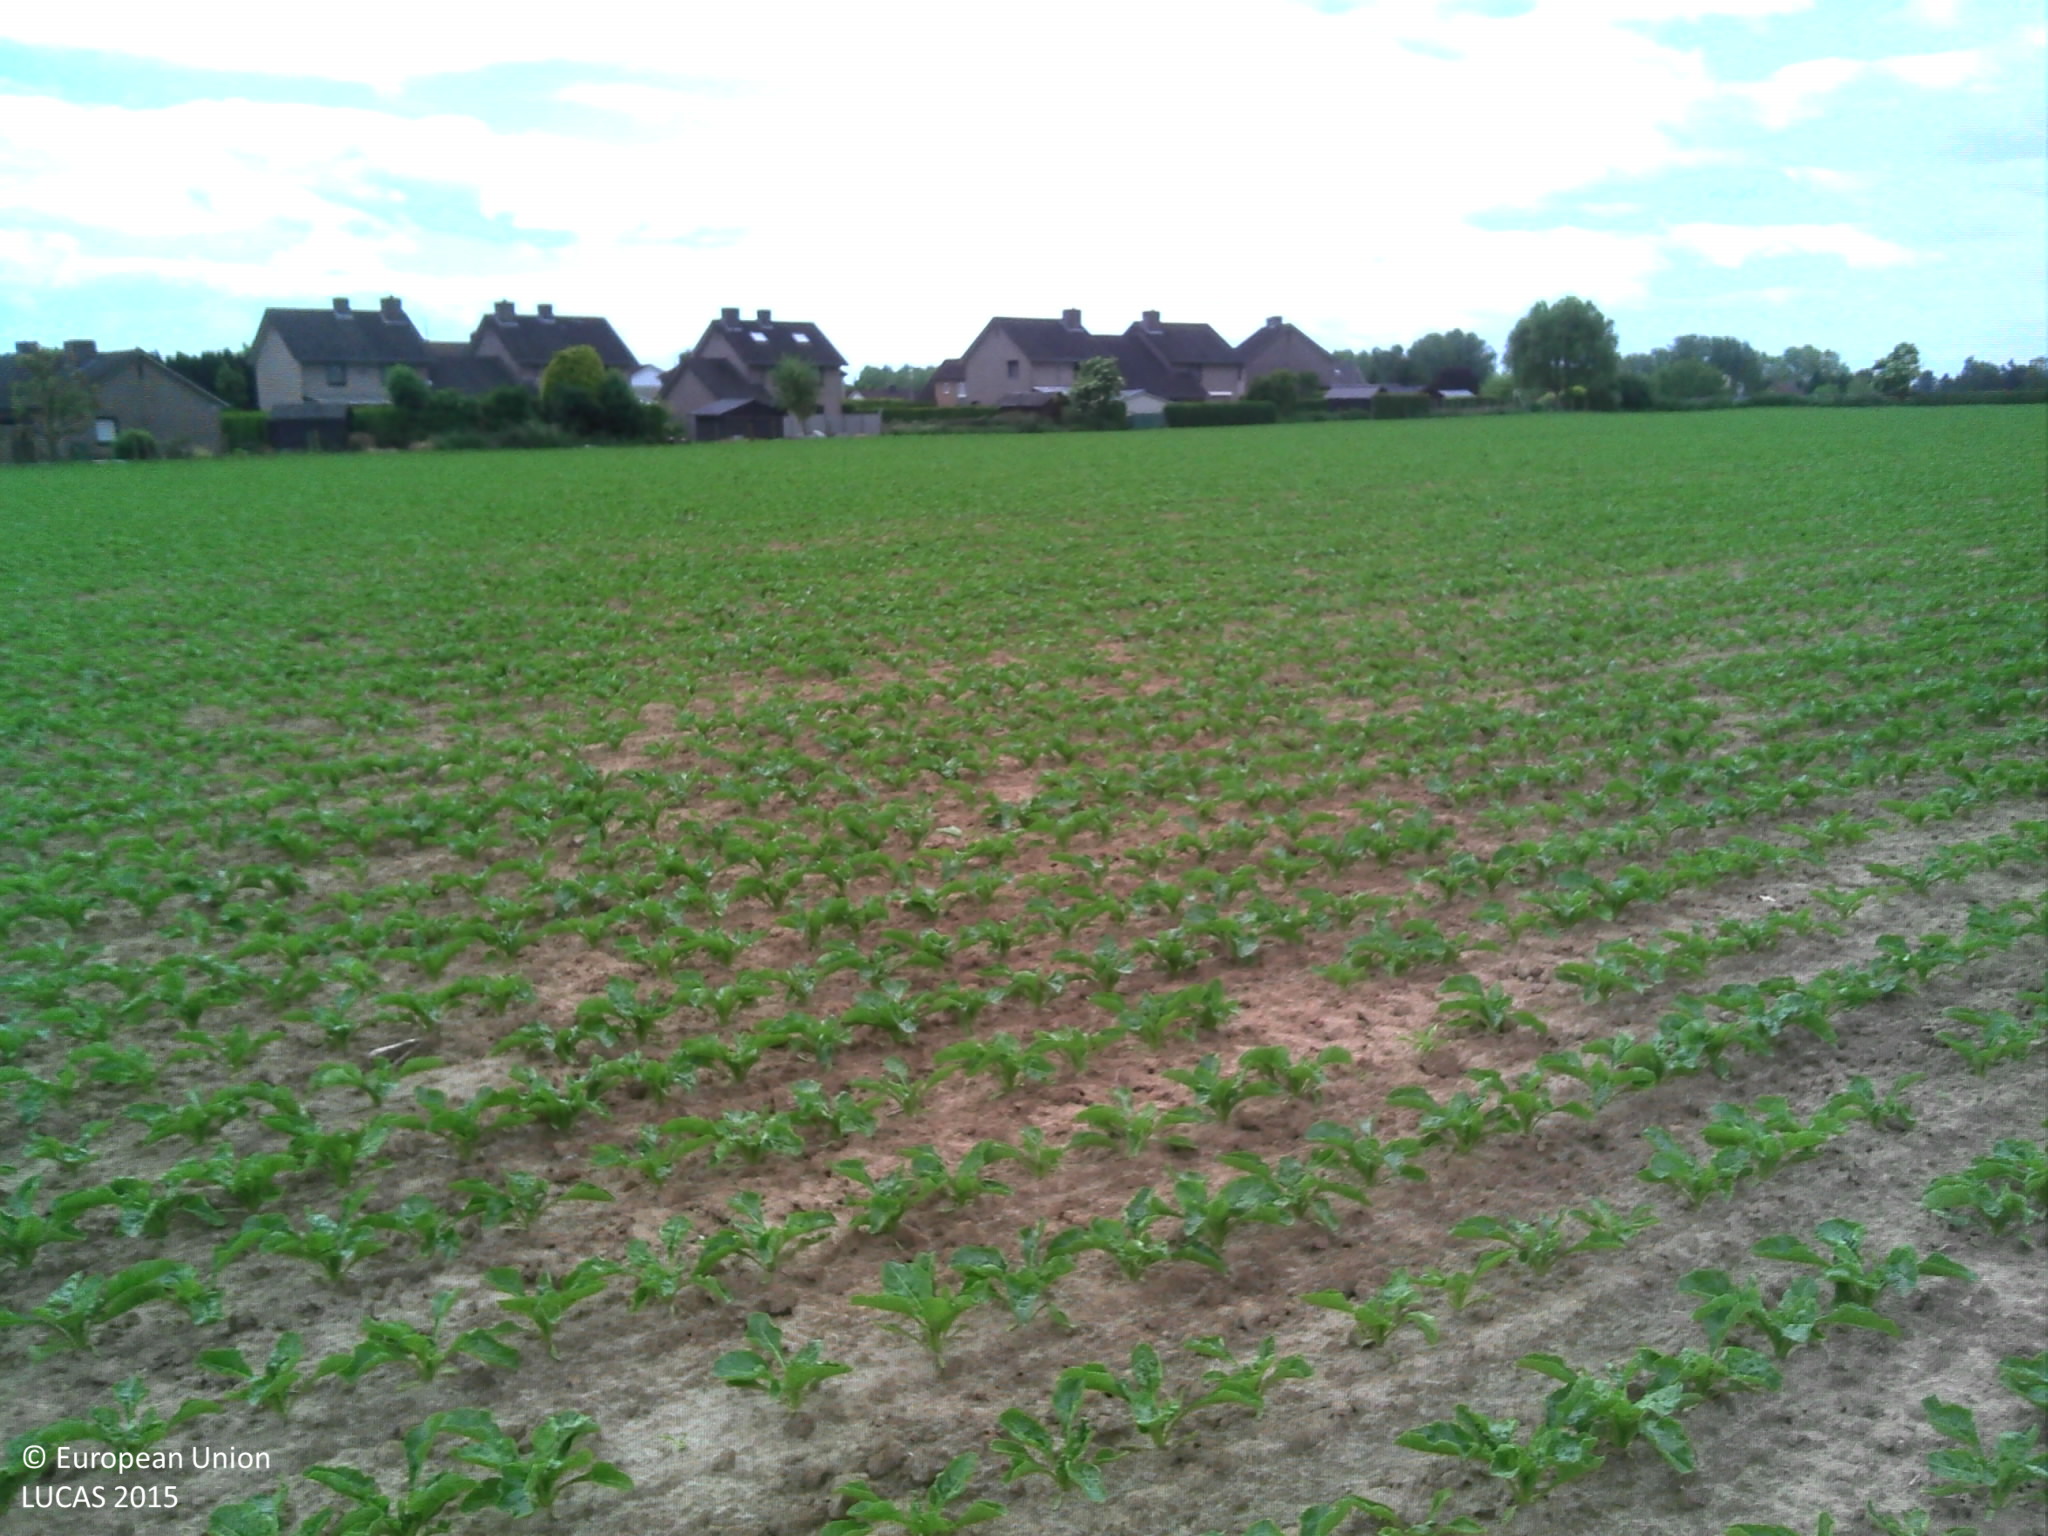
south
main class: Cropland
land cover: Sugar beet
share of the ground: 50 - 75 %
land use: Agriculture (excluding fallow land and kitchen gardens)
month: June
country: BE
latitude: 50.8564
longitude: 4.0136
